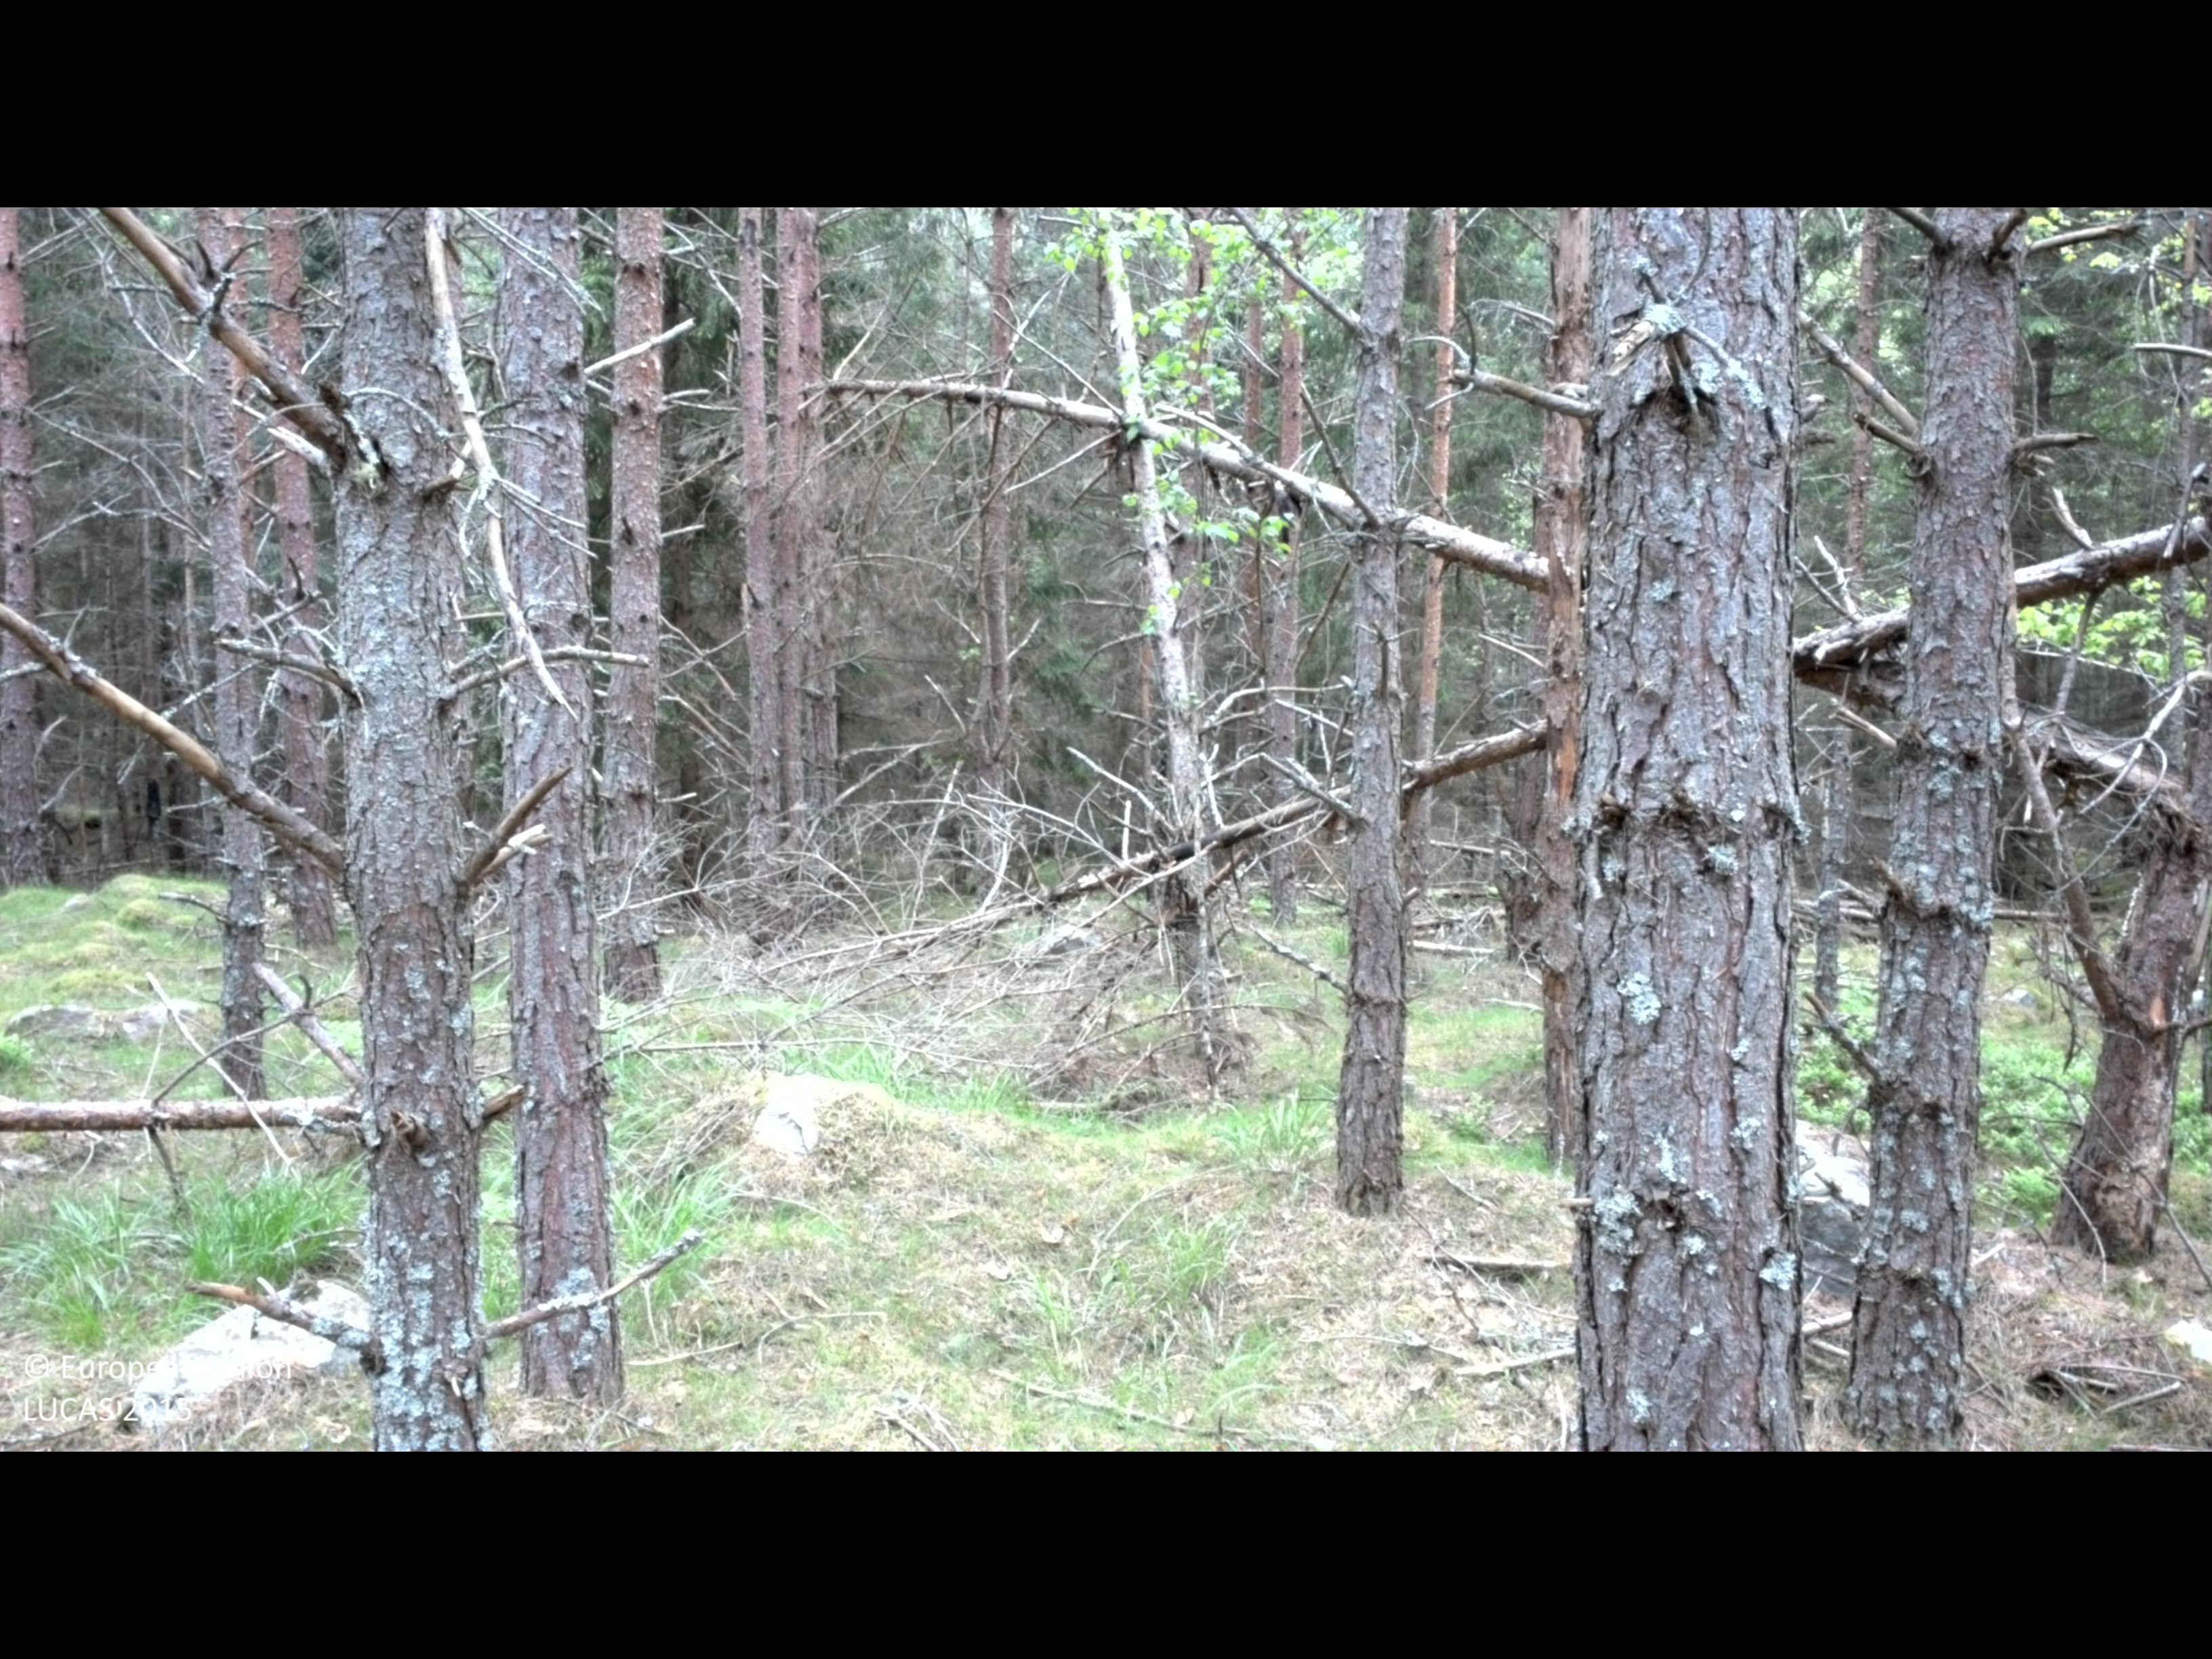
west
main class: Woodland
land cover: Pine dominated coniferous woodland
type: boreal forest
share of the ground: 50 - 75 %
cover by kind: coniferous forest trees 65 %, shrubs 10 %, herbaceous plants 10 %, lichens and mosses 10 %, broadleaved forest trees 5 %
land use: Forestry
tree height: > 5 m
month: June
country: SE
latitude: 57.7797
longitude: 16.3713
